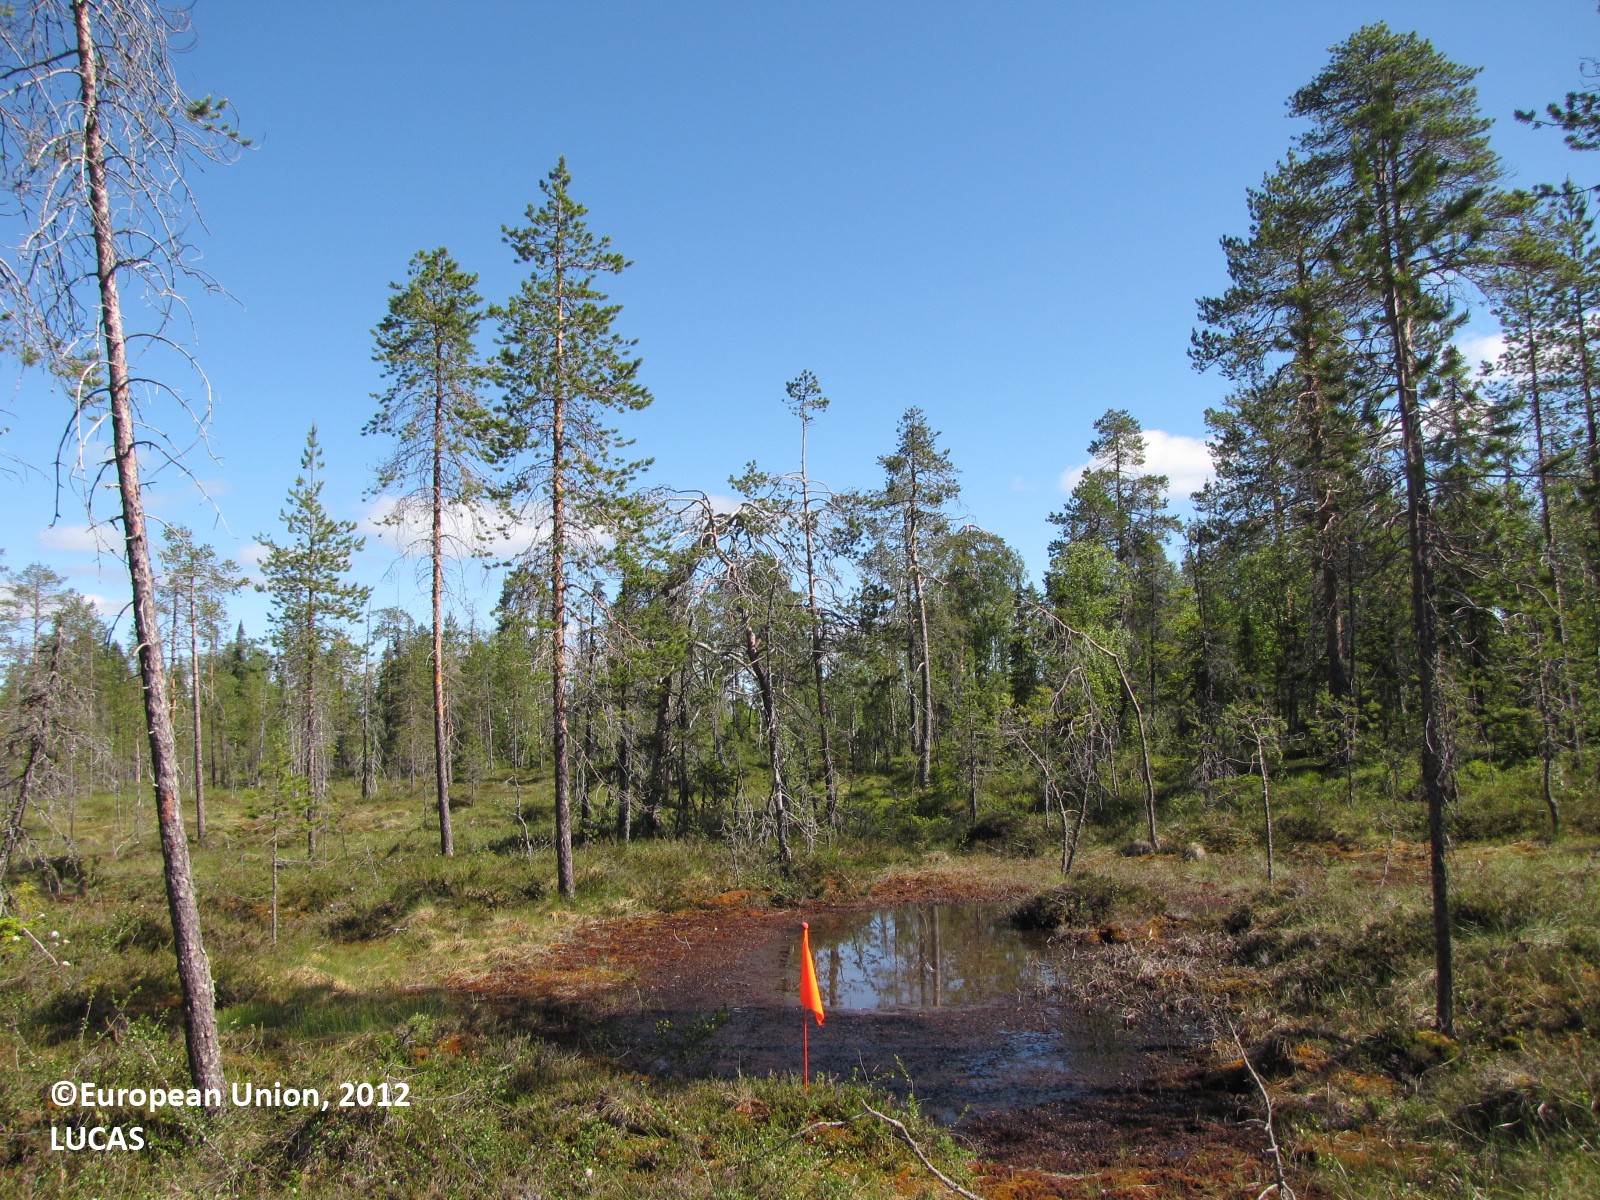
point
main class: Woodland
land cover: Pine dominated coniferous woodland
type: boreal forest
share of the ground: 25 - 50 %
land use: Forestry
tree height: > 5 m
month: July
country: FI
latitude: 66.4659
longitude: 24.8414
